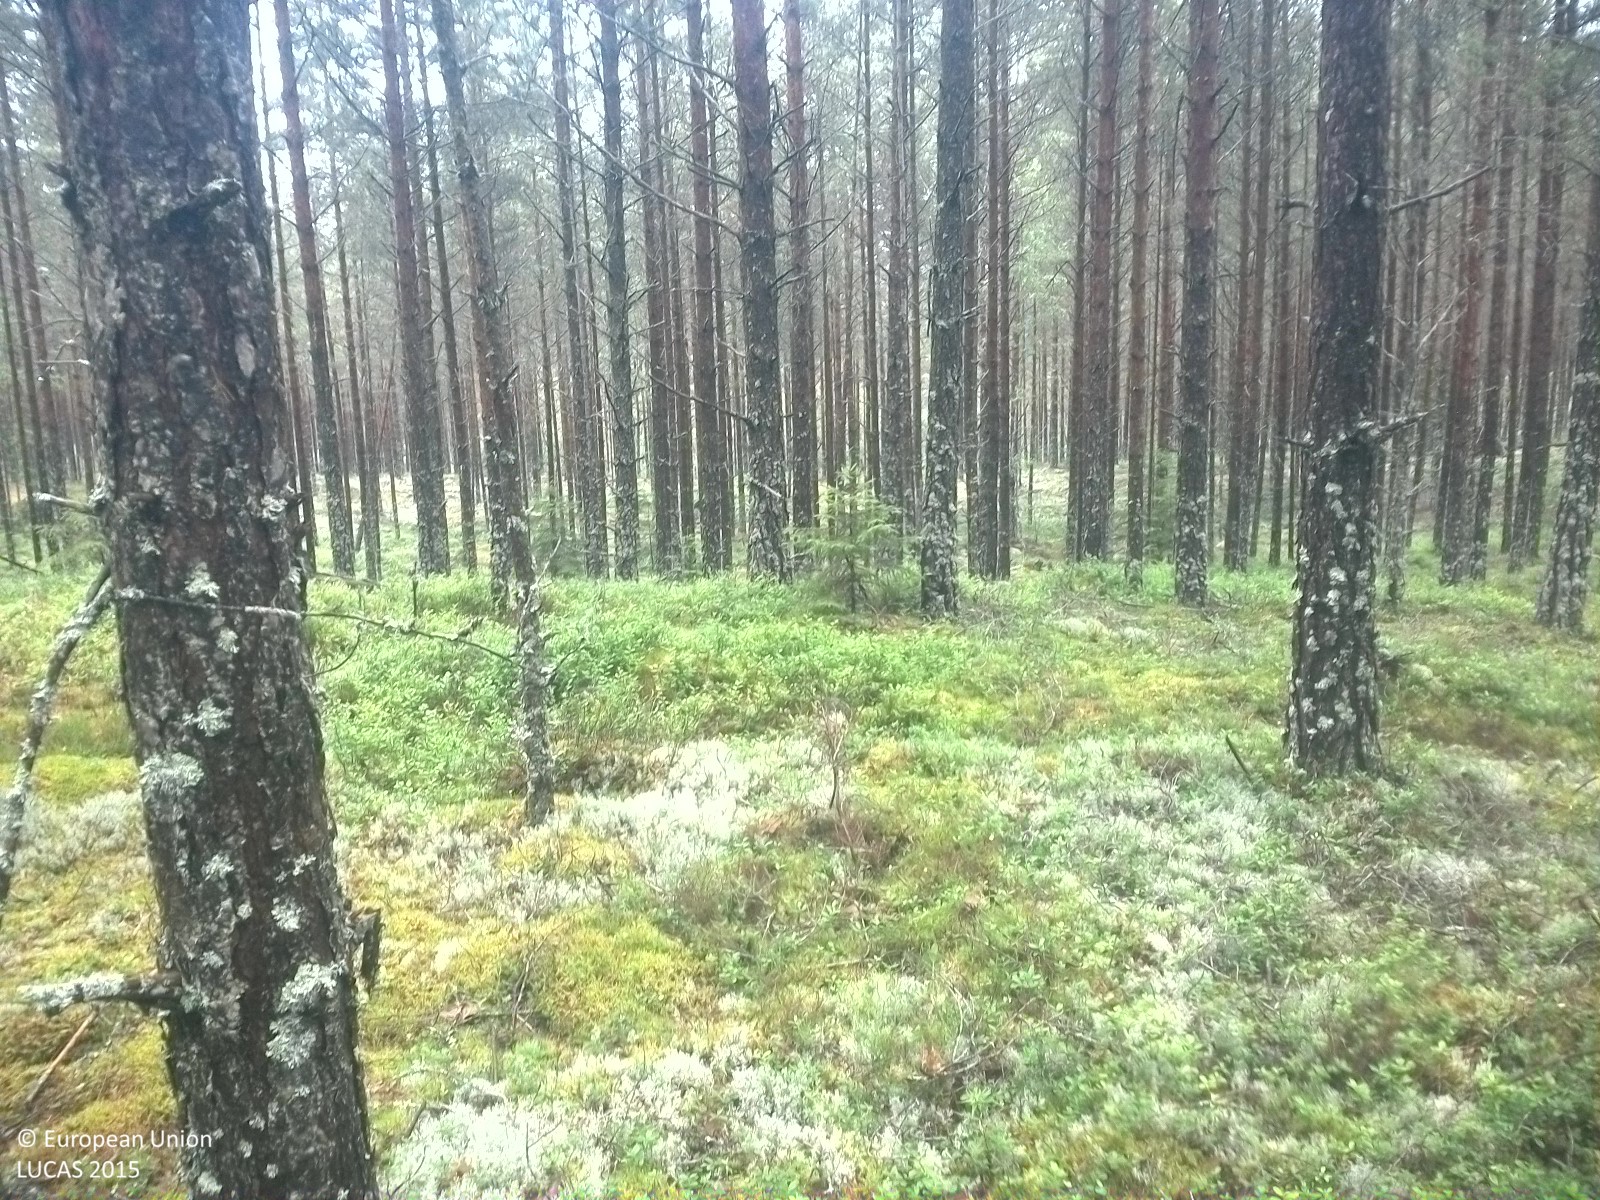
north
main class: Woodland
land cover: Pine dominated coniferous woodland
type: boreal forest
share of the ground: 25 - 50 %
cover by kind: coniferous forest trees 40 %, lichens and mosses 30 %, herbaceous plants 20 %, shrubs 10 %
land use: Forestry
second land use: Amenities, museums, leisure
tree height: > 5 m
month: July
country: SE
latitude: 58.9168
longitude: 15.0807
